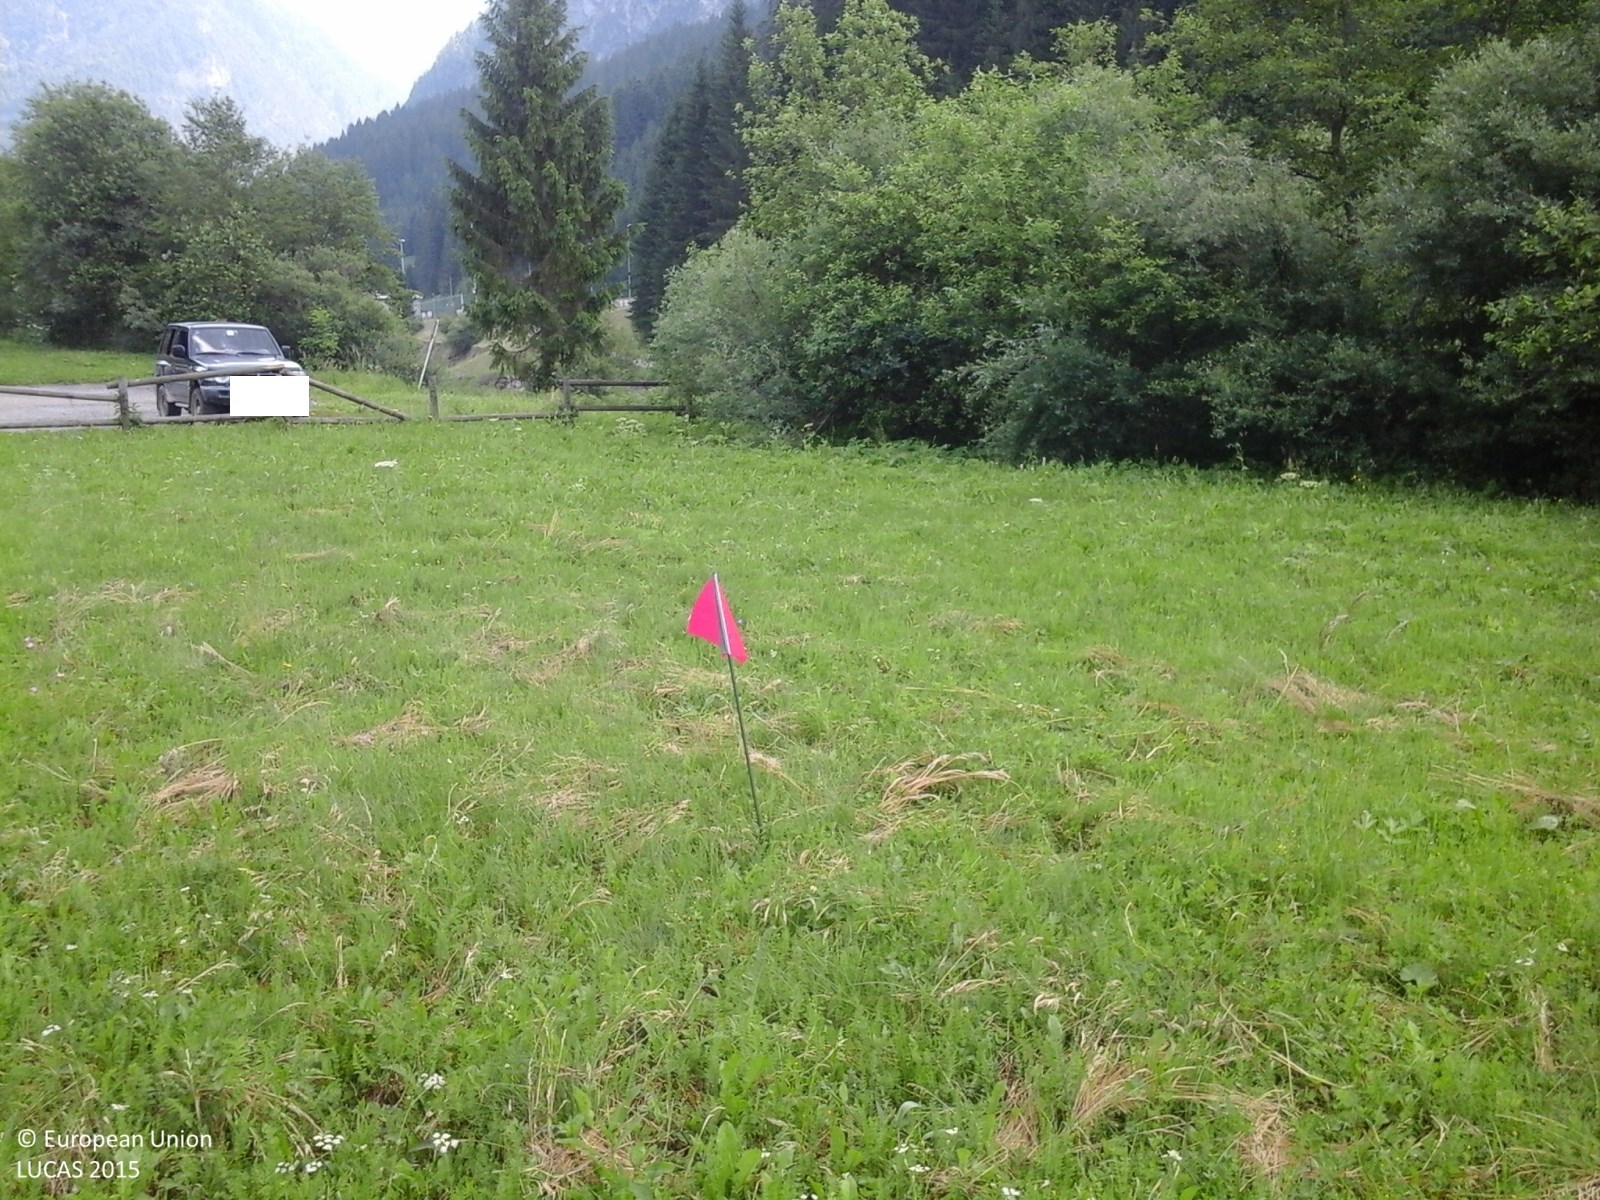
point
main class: Grassland
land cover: Grassland without tree/shrub cover
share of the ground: > 75 %
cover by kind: herbaceous plants 100 %
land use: Agriculture (excluding fallow land and kitchen gardens)
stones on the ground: 25 - 50 %
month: June
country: IT
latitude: 46.5721
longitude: 12.5938
